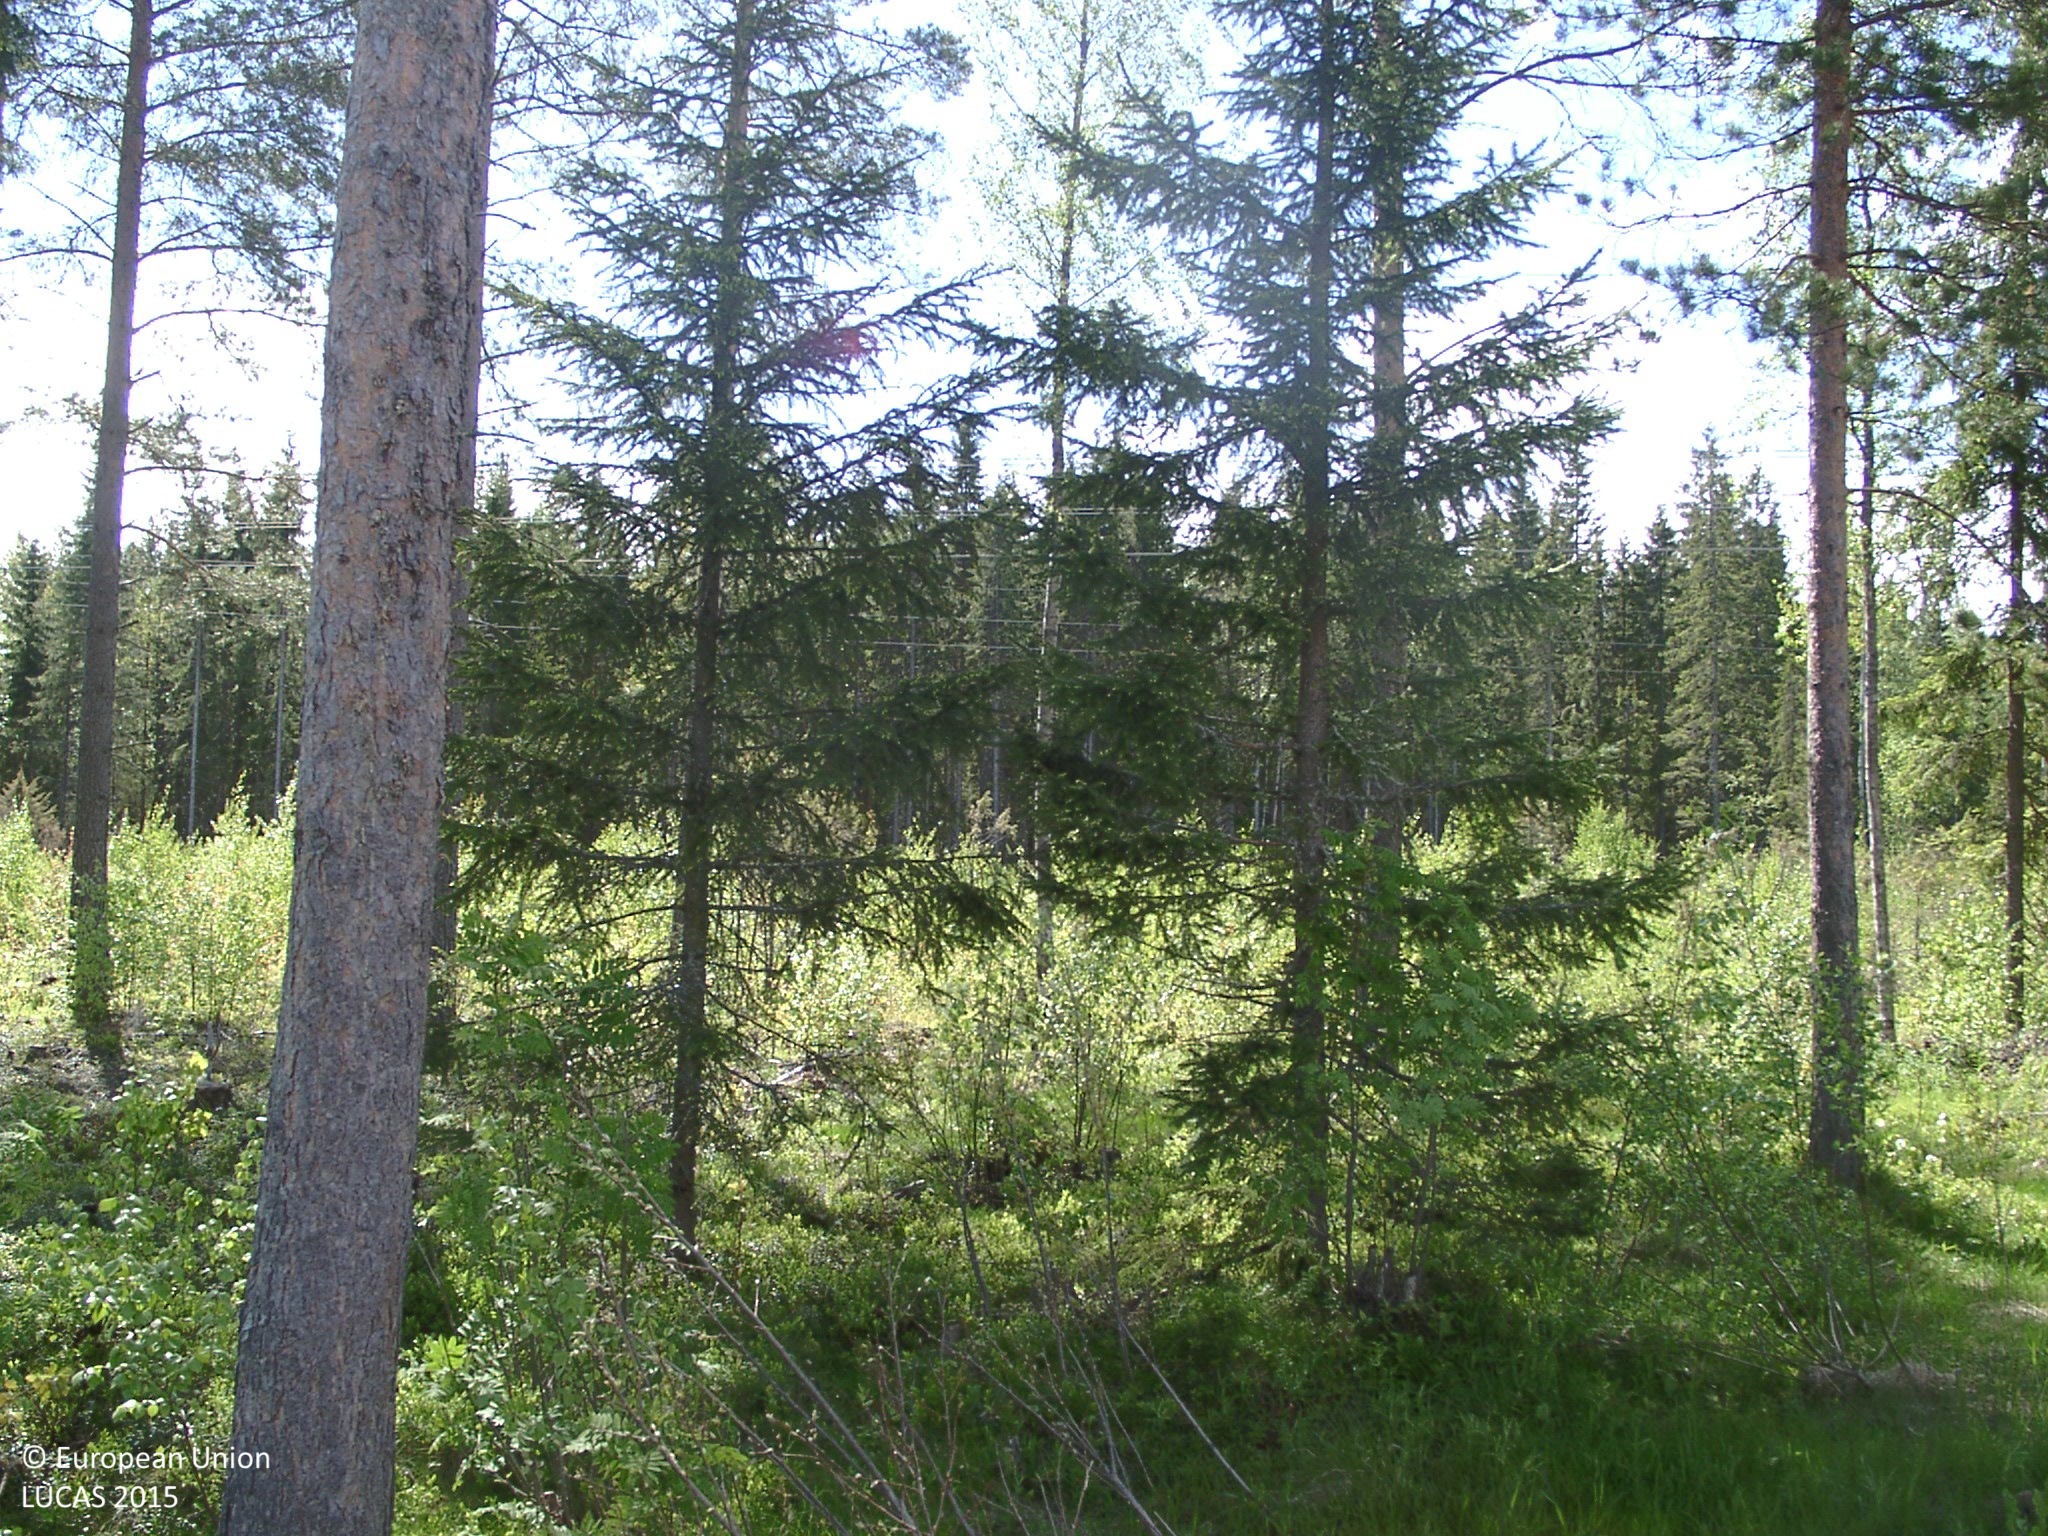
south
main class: Grassland
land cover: Grassland with sparse tree/shrub cover
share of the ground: > 75 %
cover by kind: herbaceous plants 90 %, broadleaved forest trees 5 %, shrubs 5 %
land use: Semi-natural and natural areas not in use
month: June
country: FI
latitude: 62.2298
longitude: 25.6436
